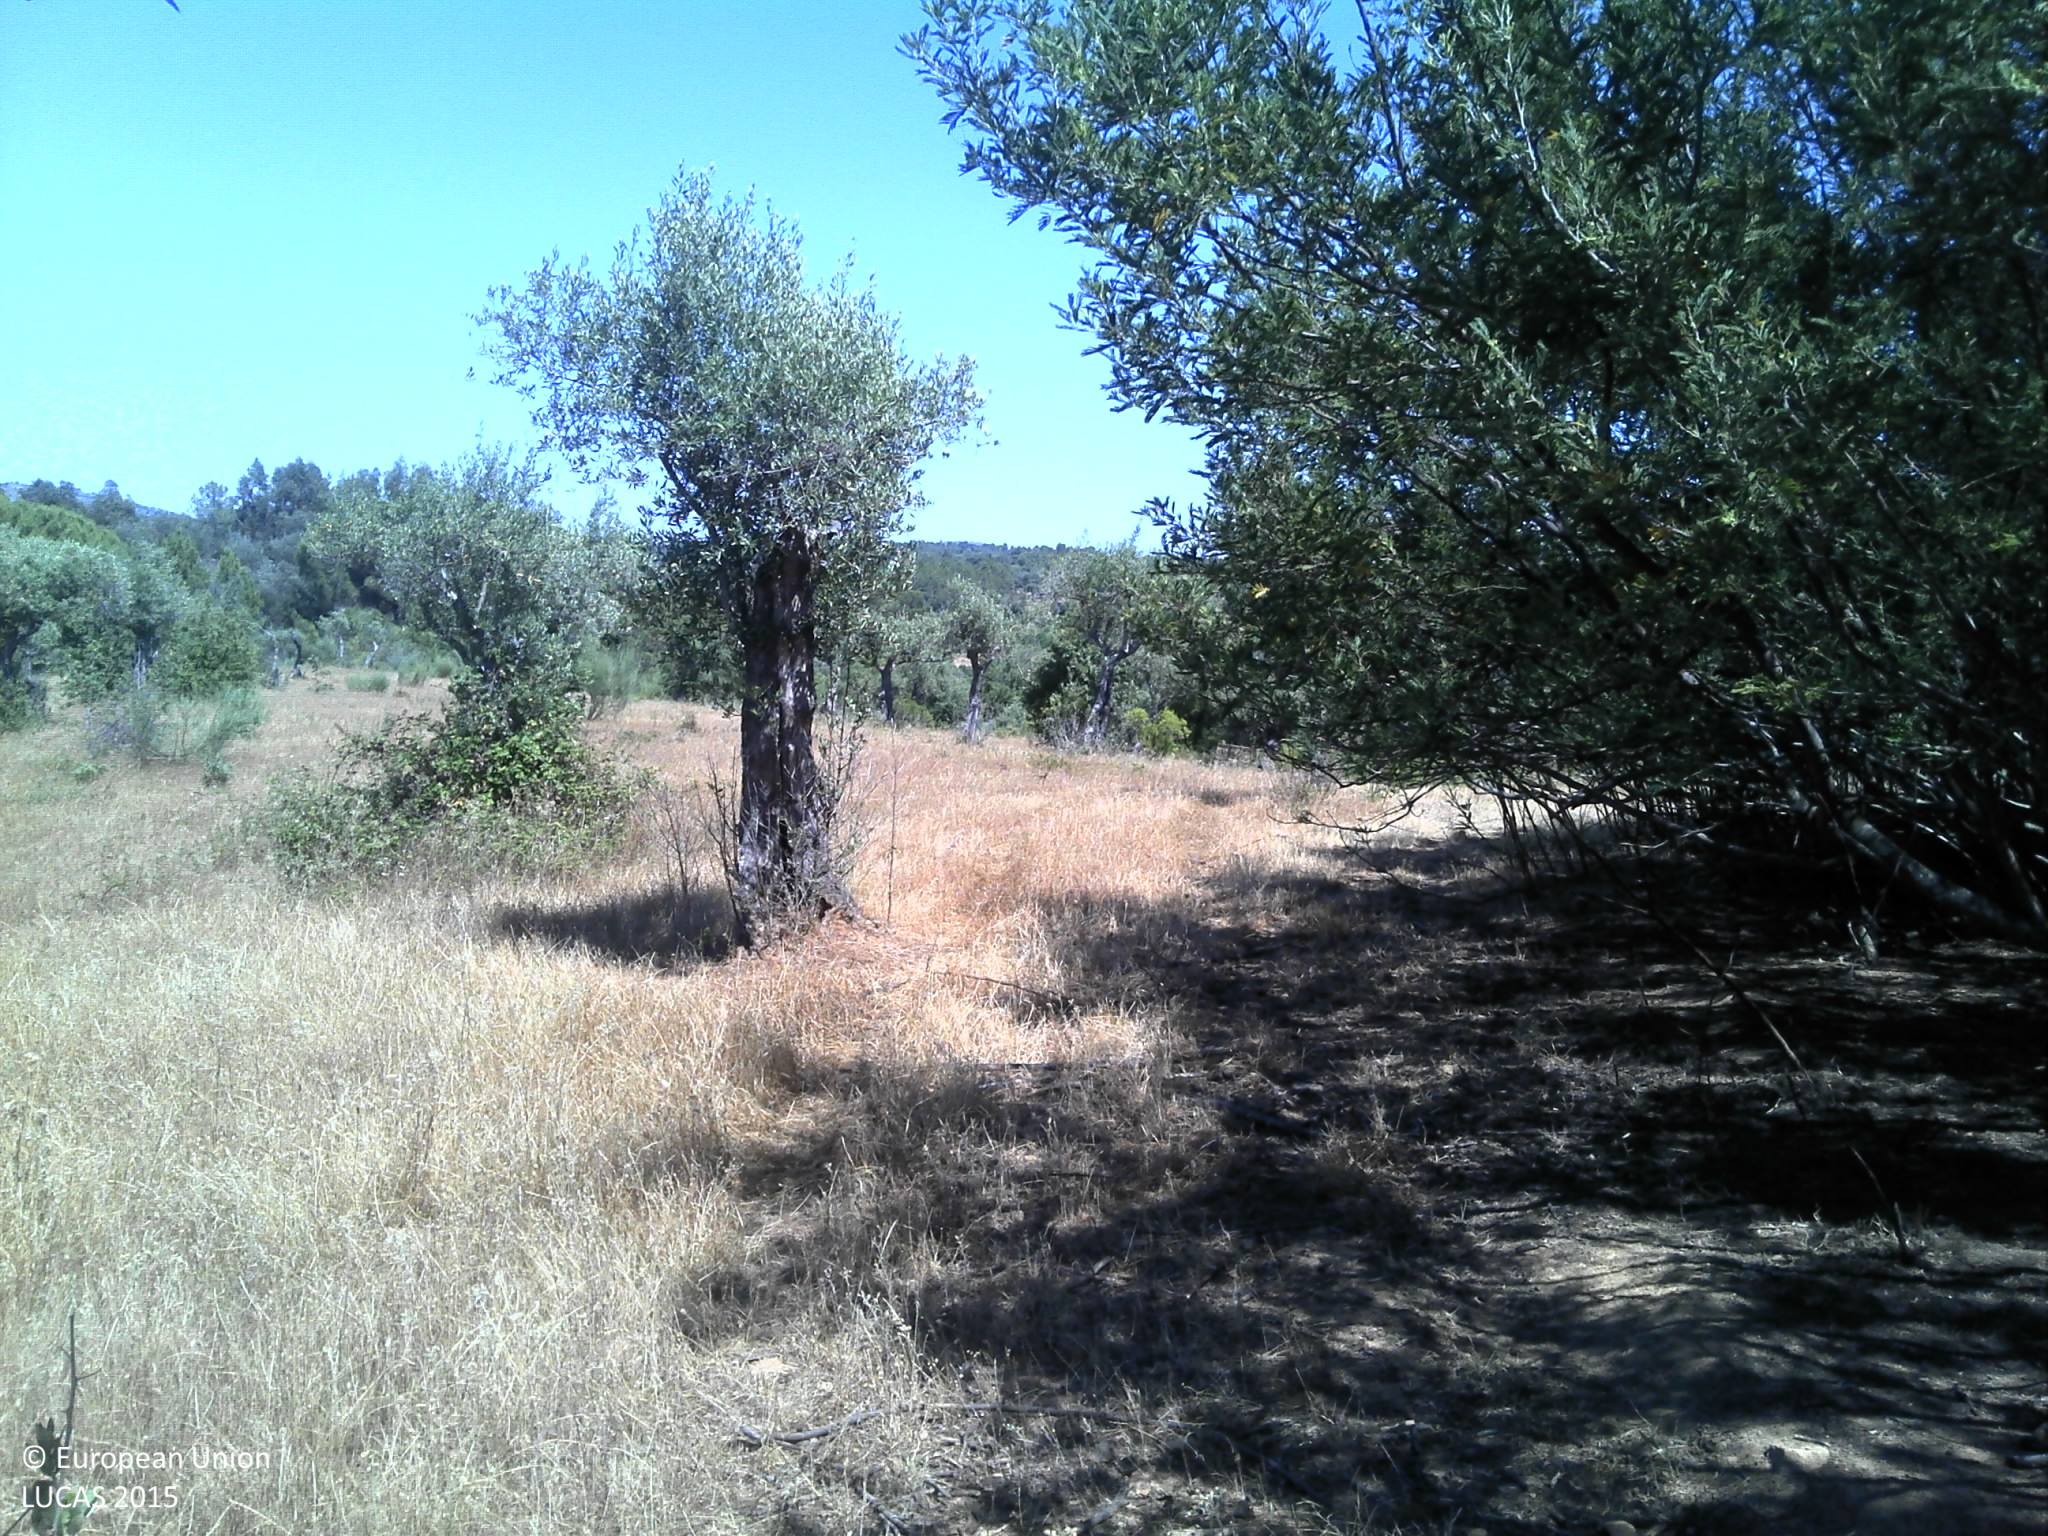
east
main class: Cropland
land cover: Olive groves
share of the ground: 25 - 50 %
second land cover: Grassland without tree/shrub cover
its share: 25 - 50 %
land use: Agriculture (excluding fallow land and kitchen gardens)
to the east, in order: Olive groves; Grassland without tree/shrub cover; Olive groves; Shrubland without tree cover; Olive groves; Shrubland without tree cover; Dry stone walls; Olive groves; Shruby margins; Ditches and canals; Shruby margins; Olive groves; Grassland with sparse tree/shrub cover; Other structural elements
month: June
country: PT
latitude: 40.0768
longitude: -7.2294
